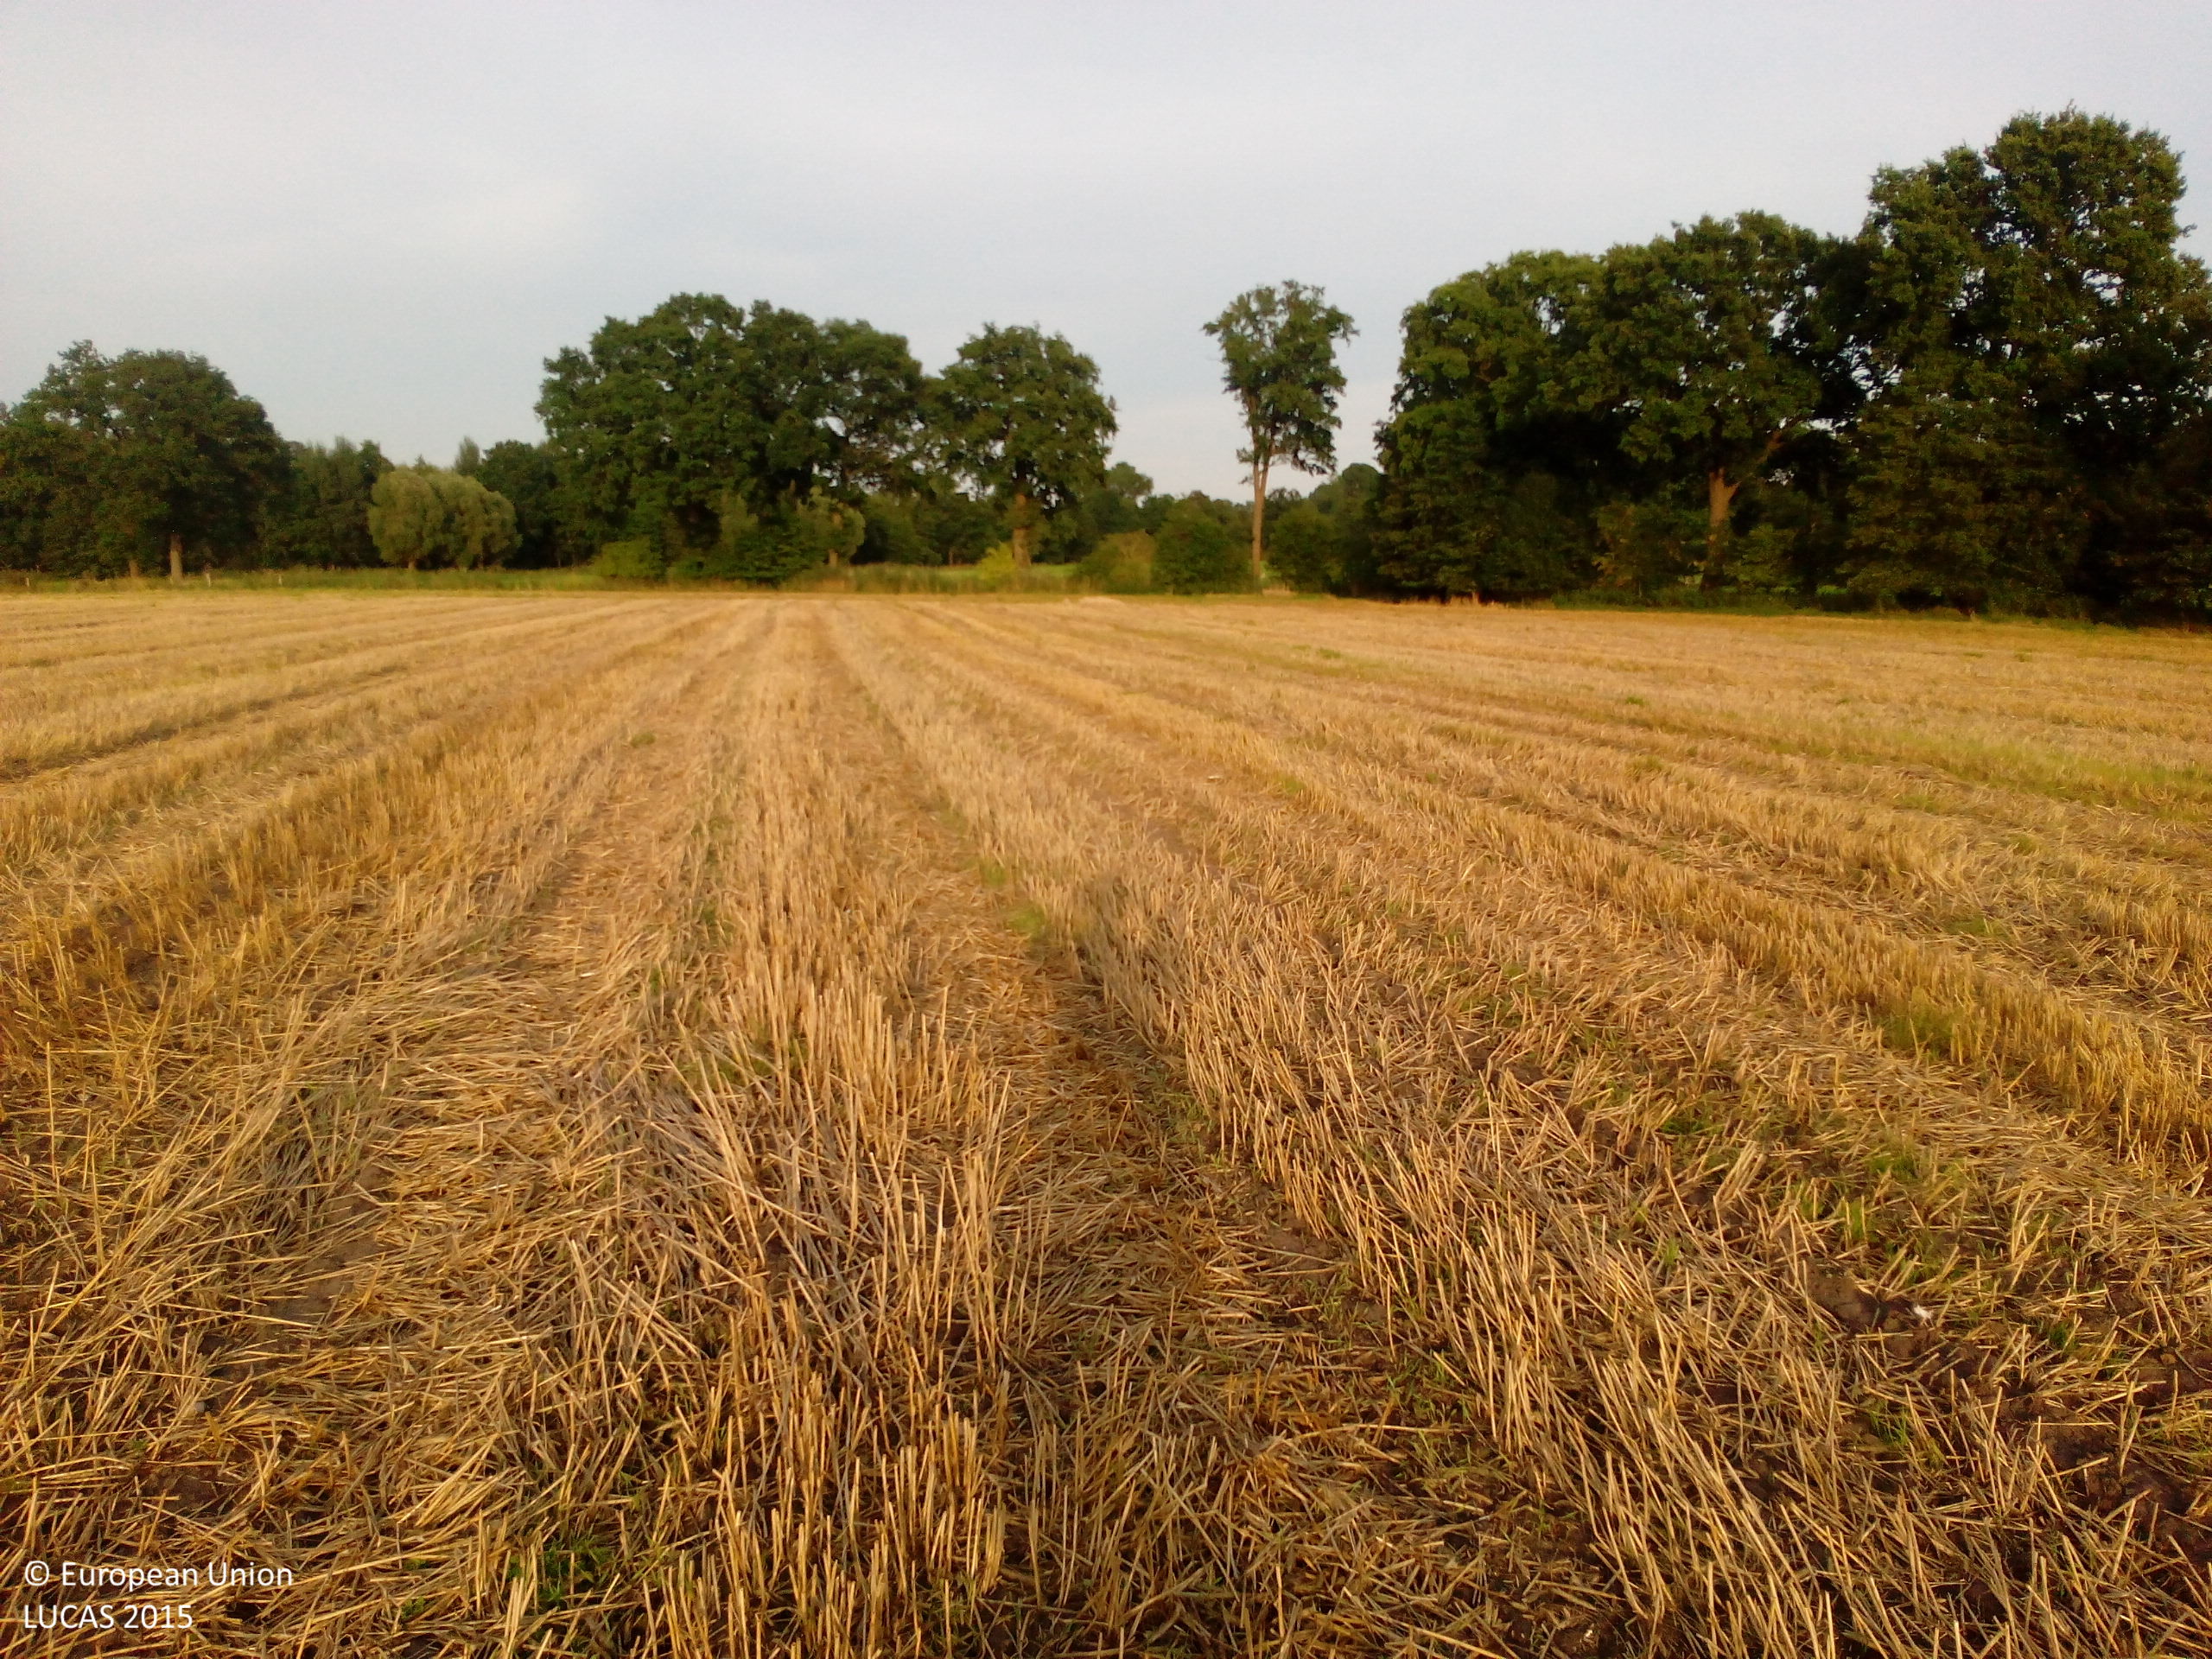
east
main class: Cropland
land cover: Rye
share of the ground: 50 - 75 %
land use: Agriculture (excluding fallow land and kitchen gardens)
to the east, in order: Rye; Broadleaved woodland; Fences; Grassland without tree/shrub cover; Fences
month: August
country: DE
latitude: 53.7074
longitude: 9.9243
